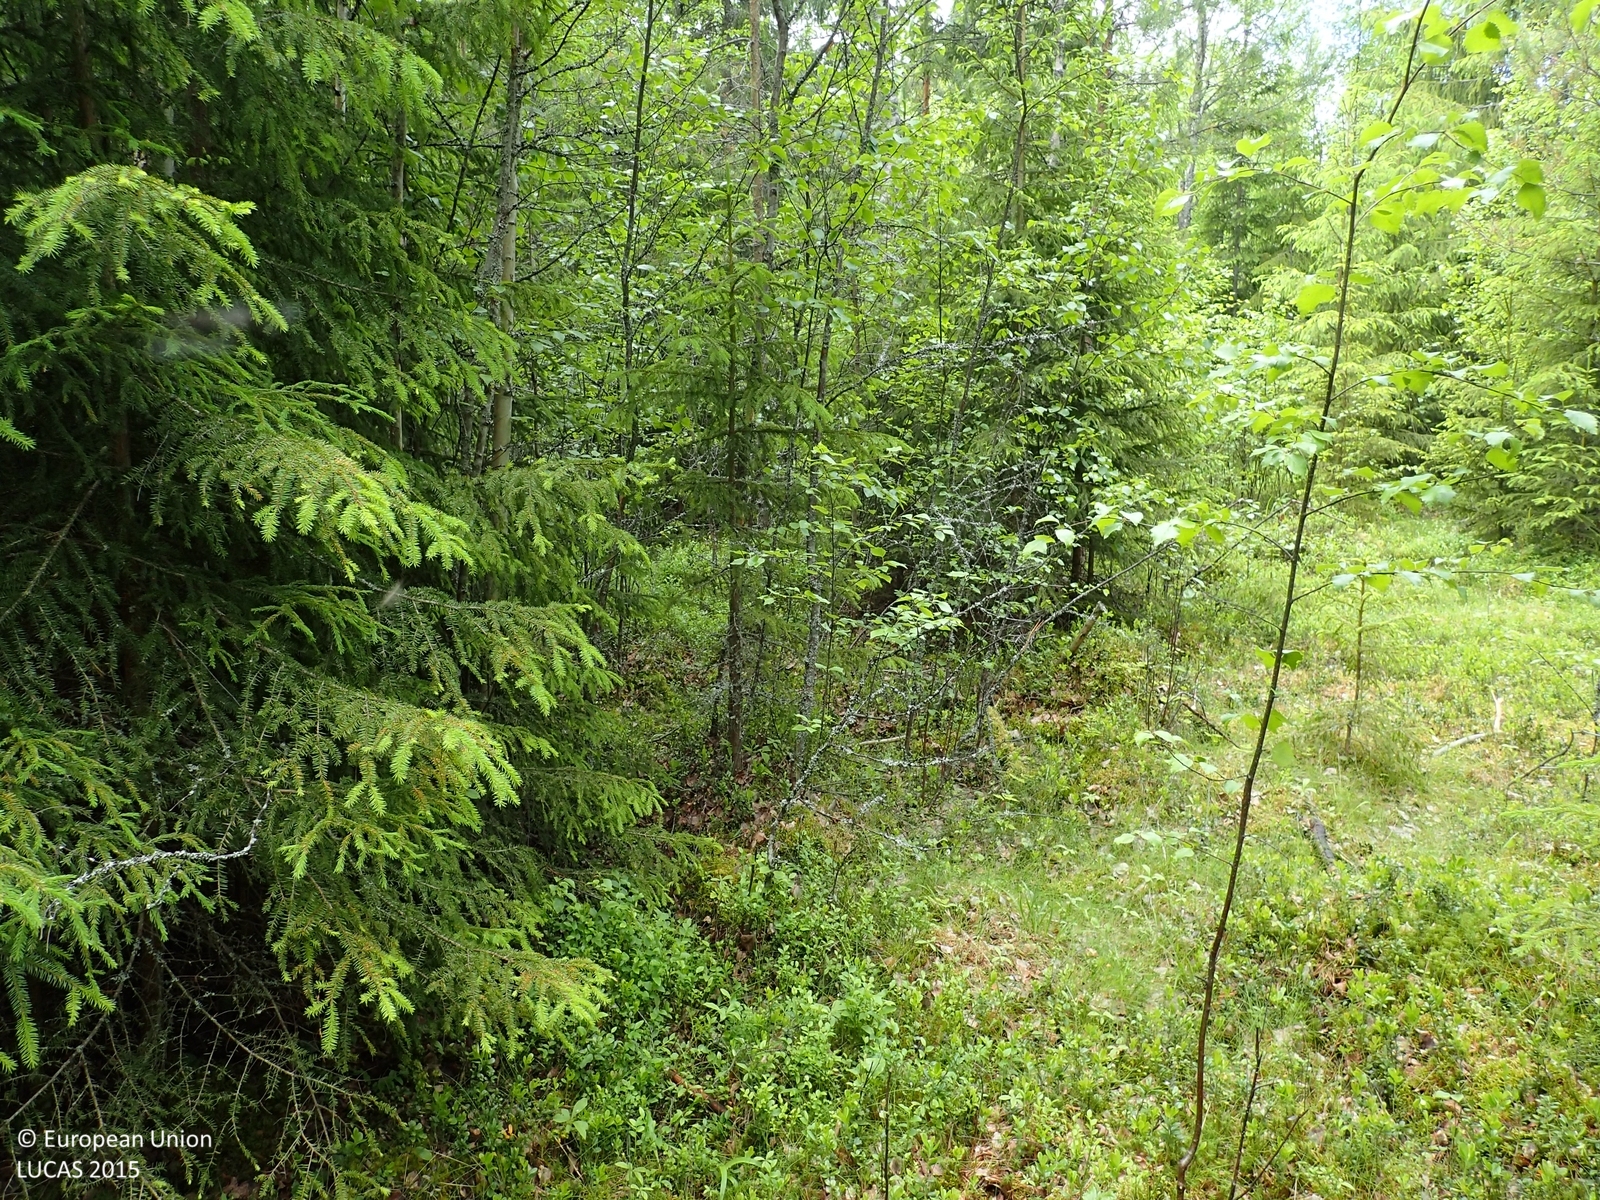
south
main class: Woodland
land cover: Other mixed woodland
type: boreal forest
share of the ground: > 75 %
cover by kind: broadleaved forest trees 45 %, coniferous forest trees 35 %, shrubs 20 %
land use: Forestry
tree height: > 5 m
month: June
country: FI
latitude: 62.3439
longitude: 21.3792
